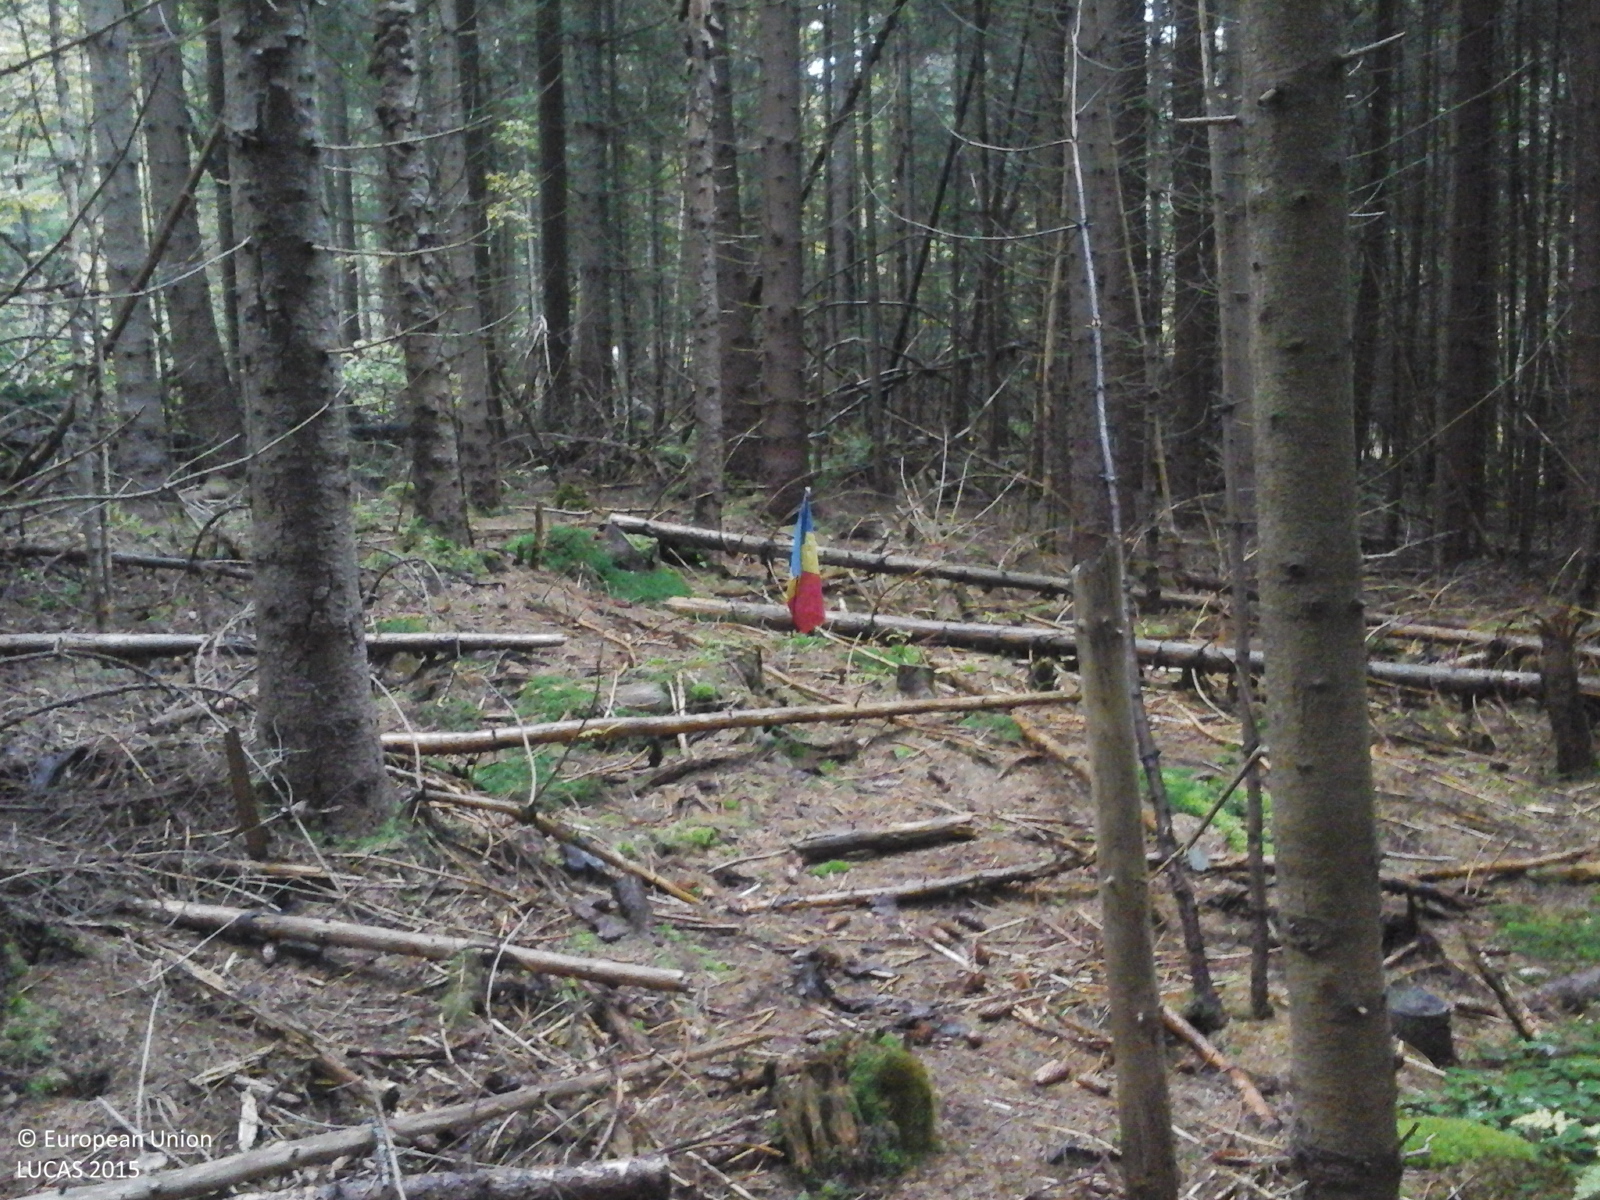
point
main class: Woodland
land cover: Spruce dominated coniferous woodland
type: alpine coniferous forest
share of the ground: > 75 %
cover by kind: coniferous forest trees 100 %
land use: Forestry
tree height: > 5 m
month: October
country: RO
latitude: 46.8291
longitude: 25.2200
